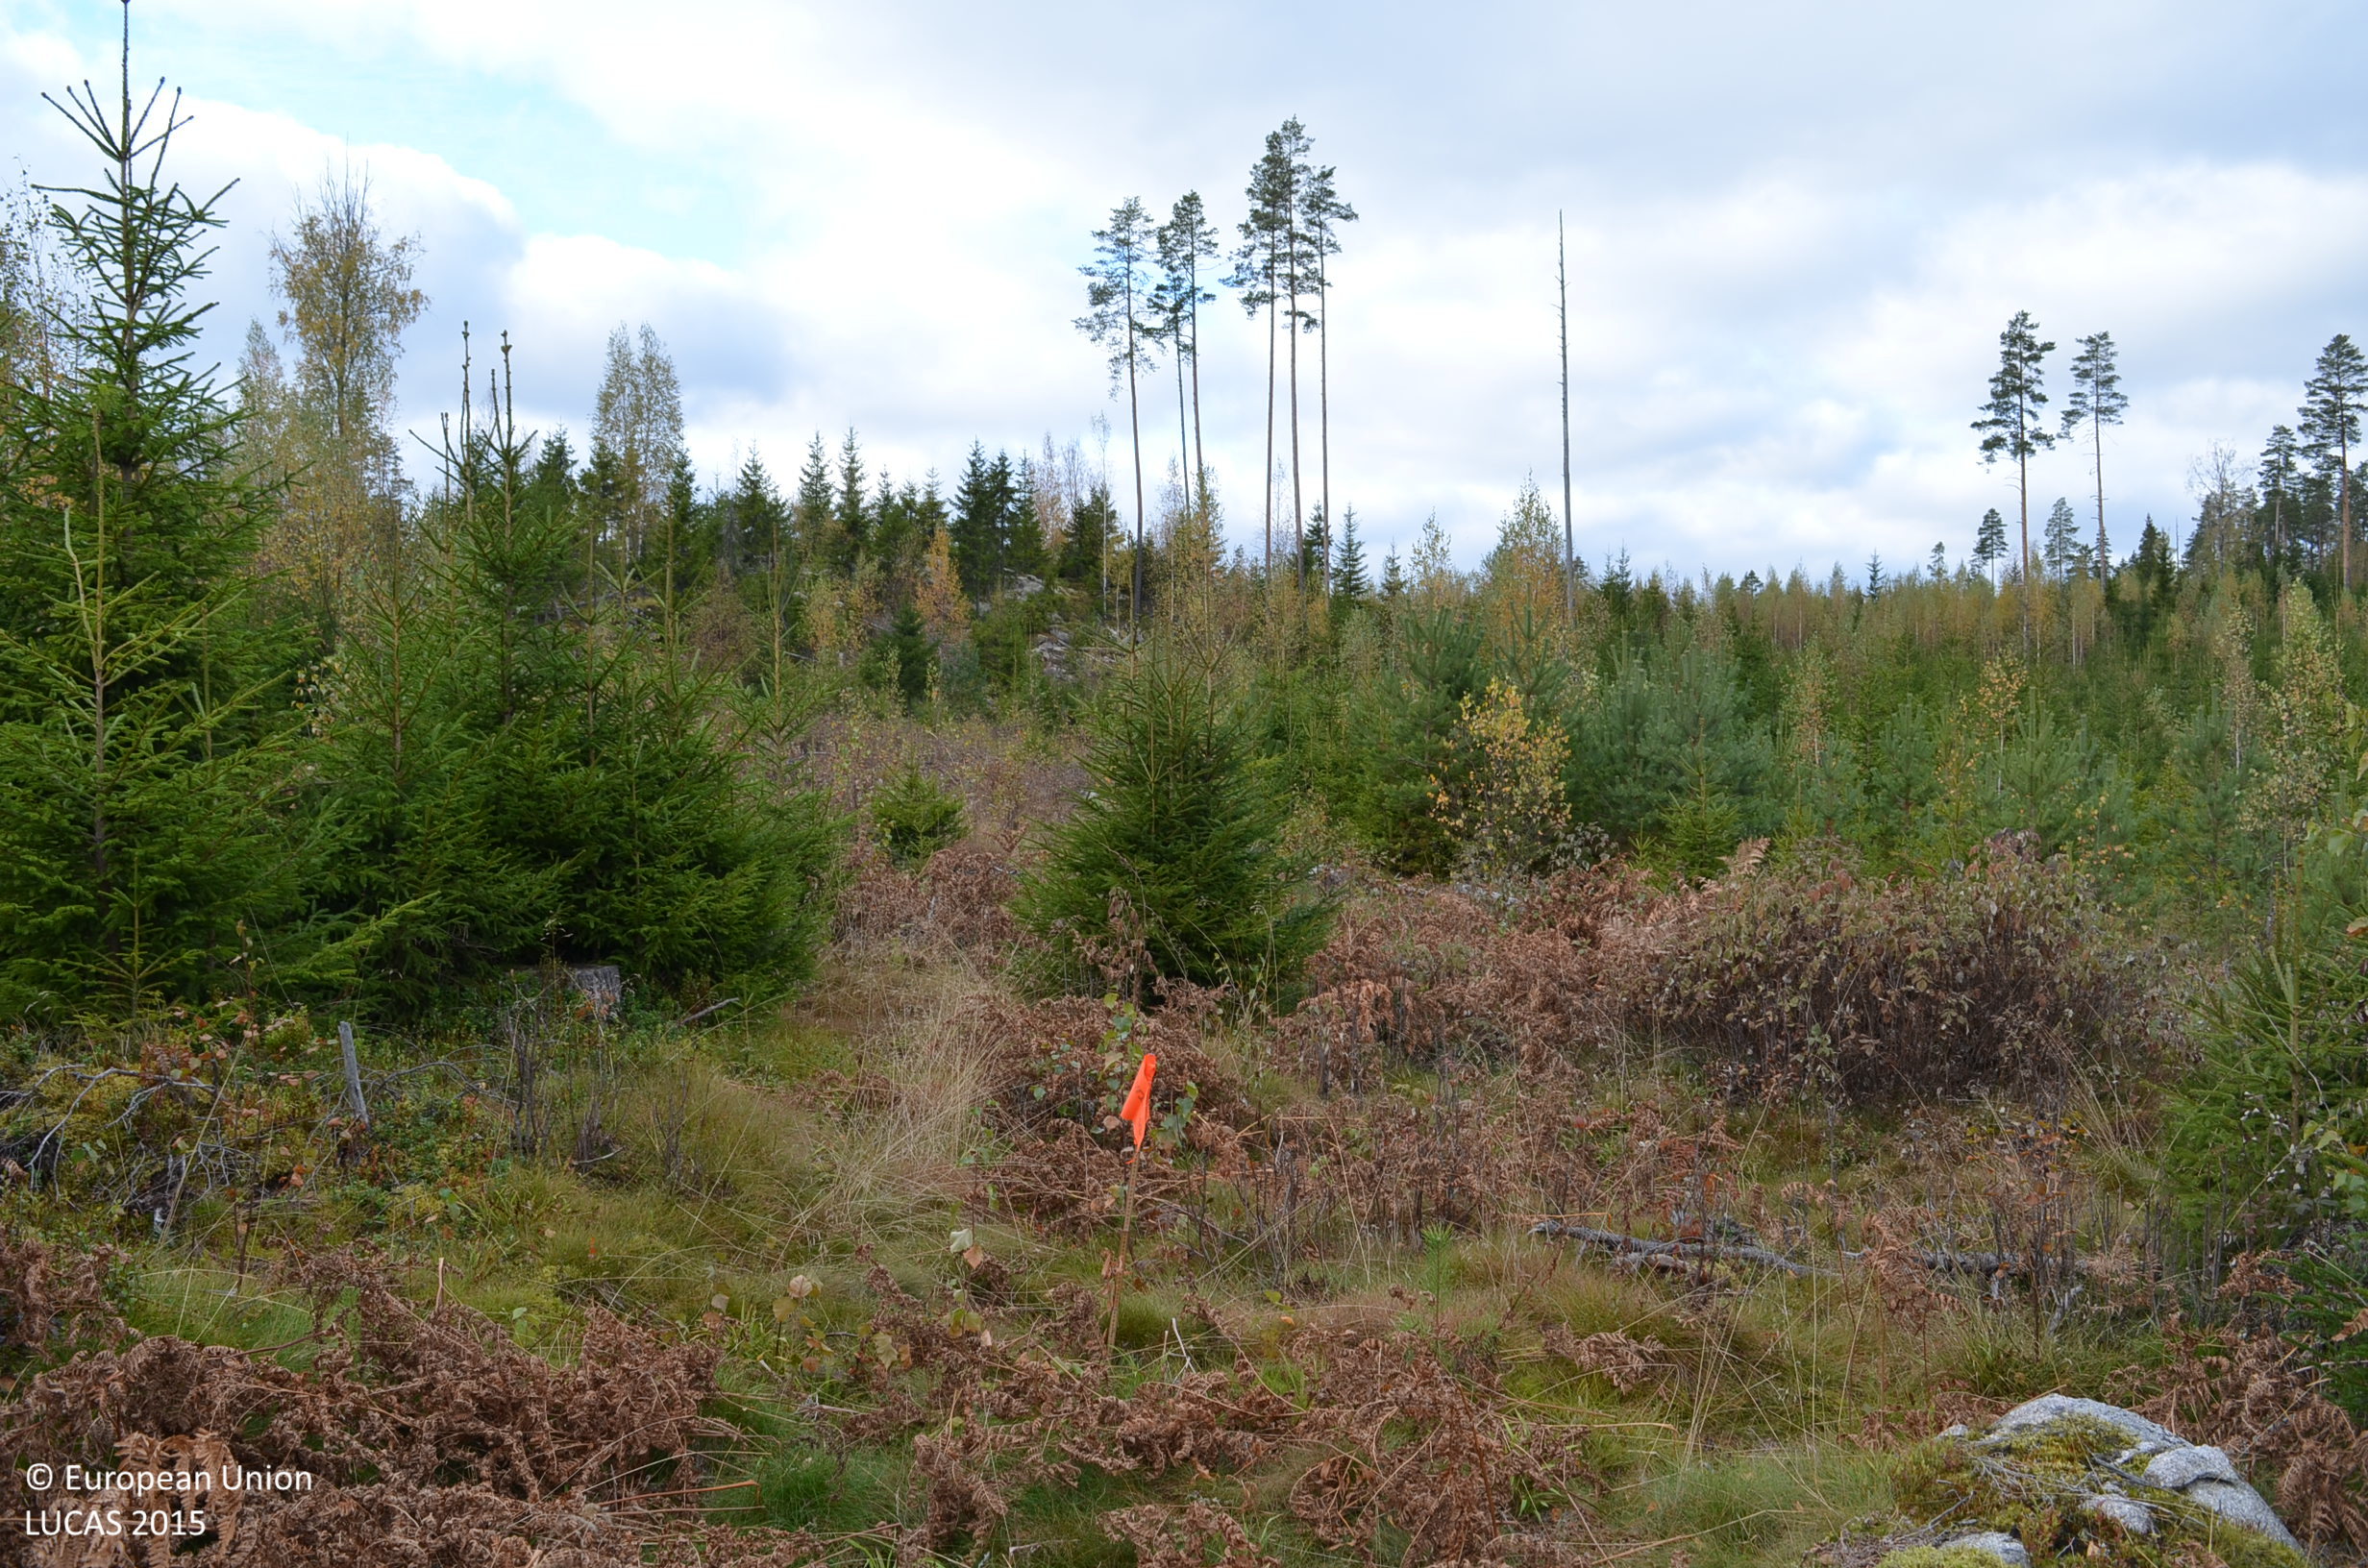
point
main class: Woodland
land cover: Other mixed woodland
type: boreal forest
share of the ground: 50 - 75 %
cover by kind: coniferous forest trees 45 %, shrubs 20 %, herbaceous plants 20 %, broadleaved forest trees 15 %
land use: Forestry
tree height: < 5 m
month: October
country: FI
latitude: 61.6808
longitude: 23.9755
